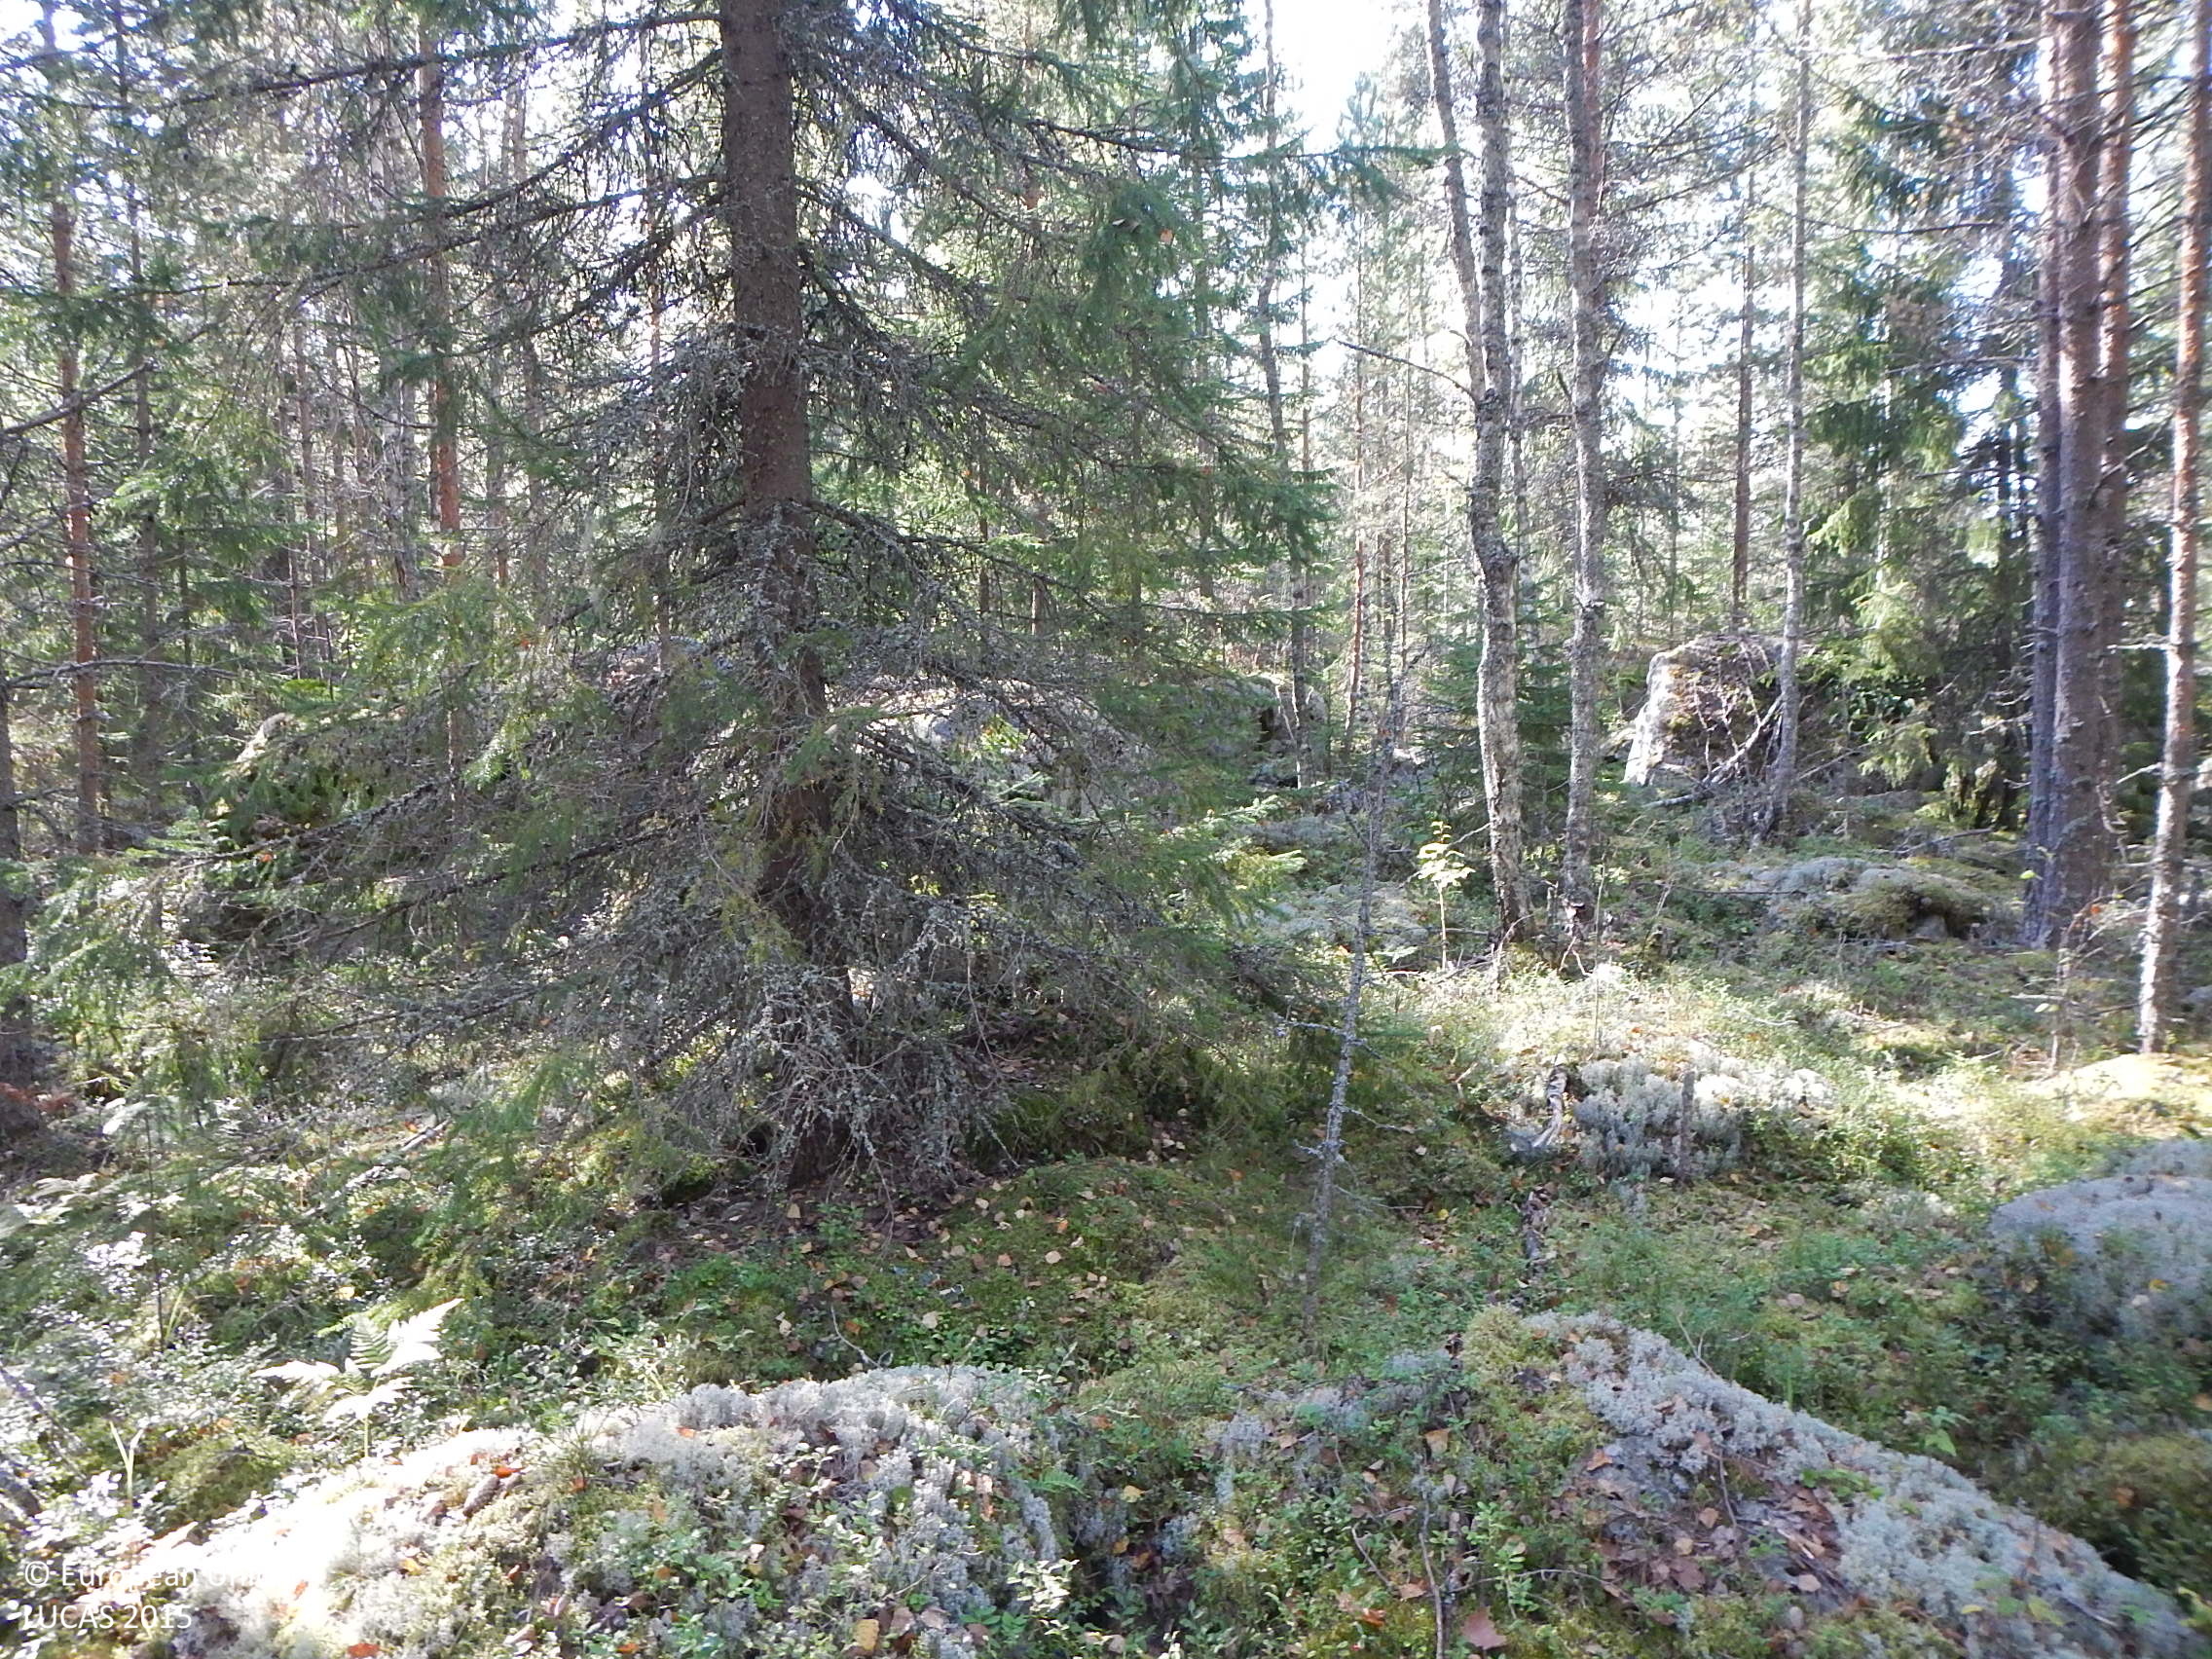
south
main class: Woodland
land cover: Other mixed woodland
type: boreal forest
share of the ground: > 75 %
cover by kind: coniferous forest trees 50 %, broadleaved forest trees 25 %, shrubs 20 %, lichens and mosses 5 %
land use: Forestry
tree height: > 5 m
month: September
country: FI
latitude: 61.5865
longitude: 22.1717
